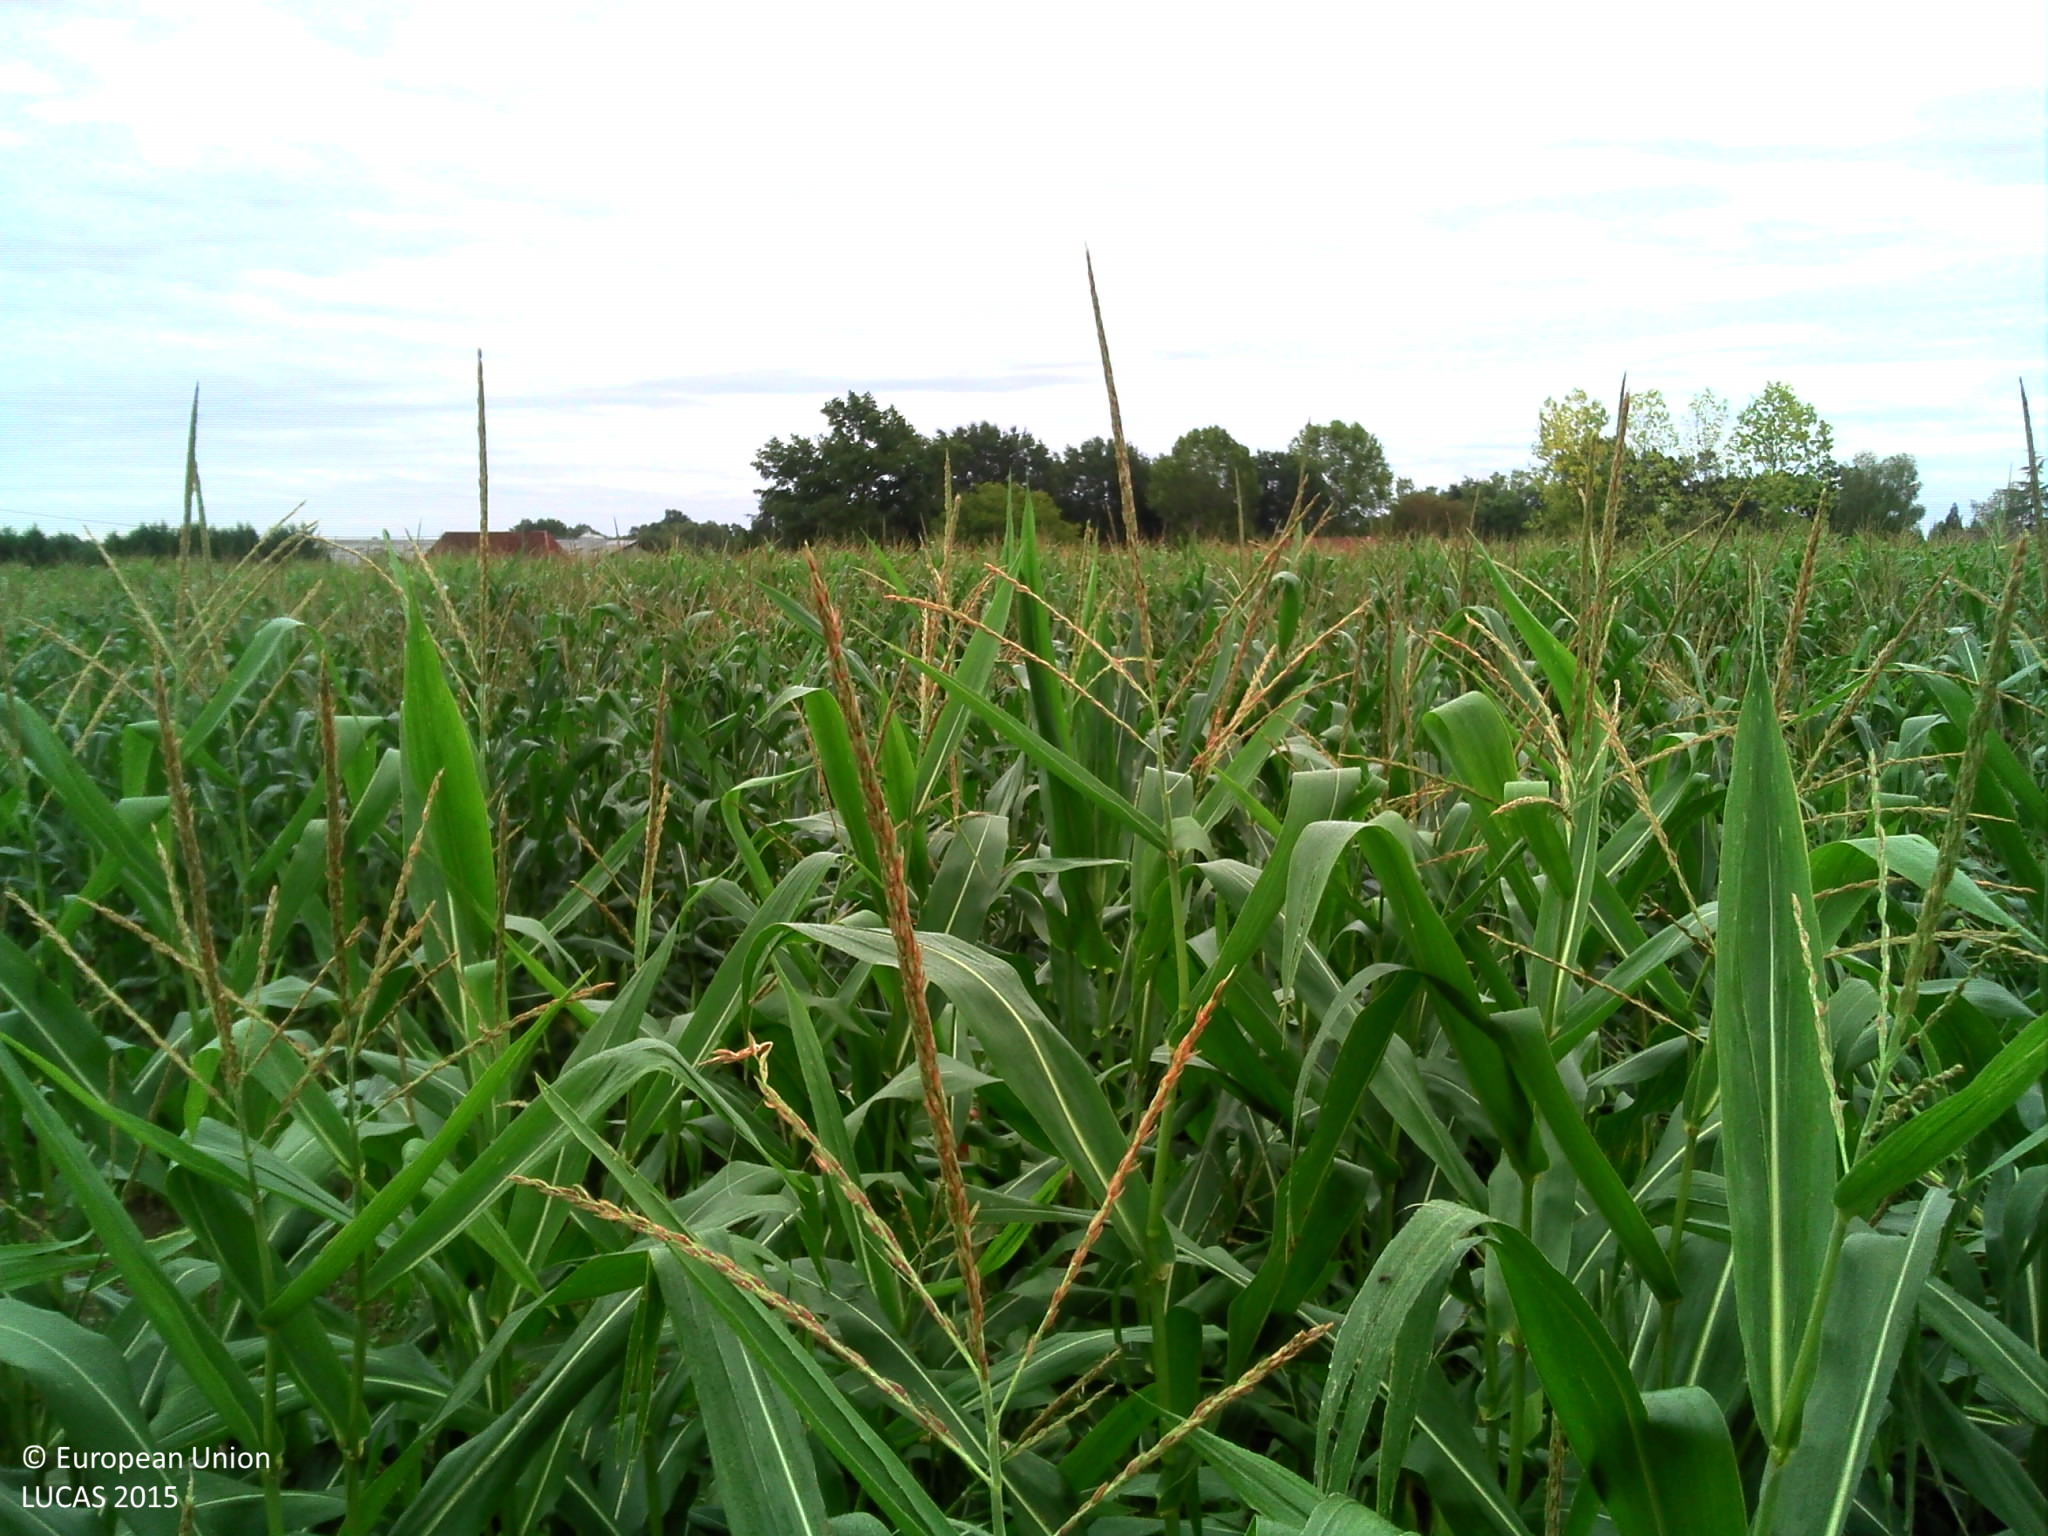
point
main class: Cropland
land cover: Maize
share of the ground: > 75 %
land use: Agriculture (excluding fallow land and kitchen gardens)
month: September
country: FR
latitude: 43.4706
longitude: -0.5040
